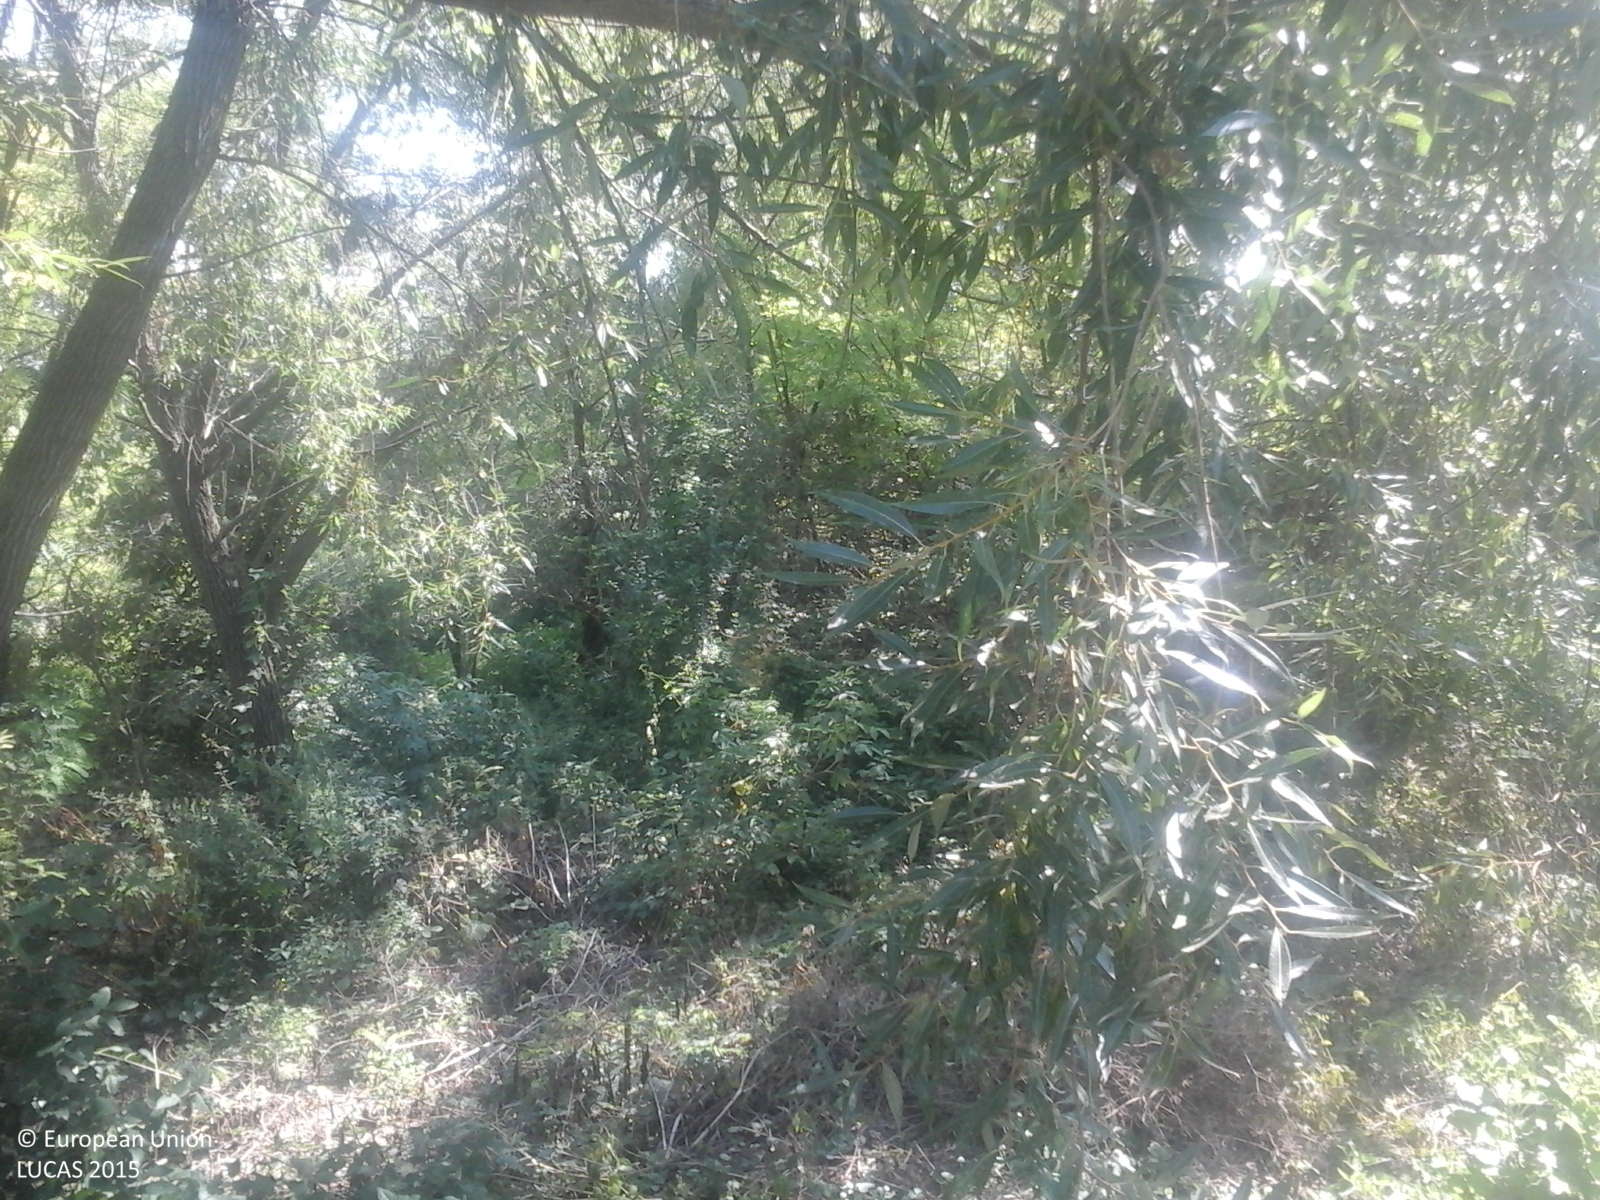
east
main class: Woodland
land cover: Broadleaved woodland
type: exotic forest
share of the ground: > 75 %
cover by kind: broadleaved forest trees 100 %
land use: Forestry
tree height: > 5 m
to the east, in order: Broadleaved woodland; Artificial constructions in urban areas; Vineyards; Artificial constructions in urban areas; Spontaneously vegetated surfaces; Ditches and canals
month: July
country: RO
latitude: 46.6793
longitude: 28.0530
